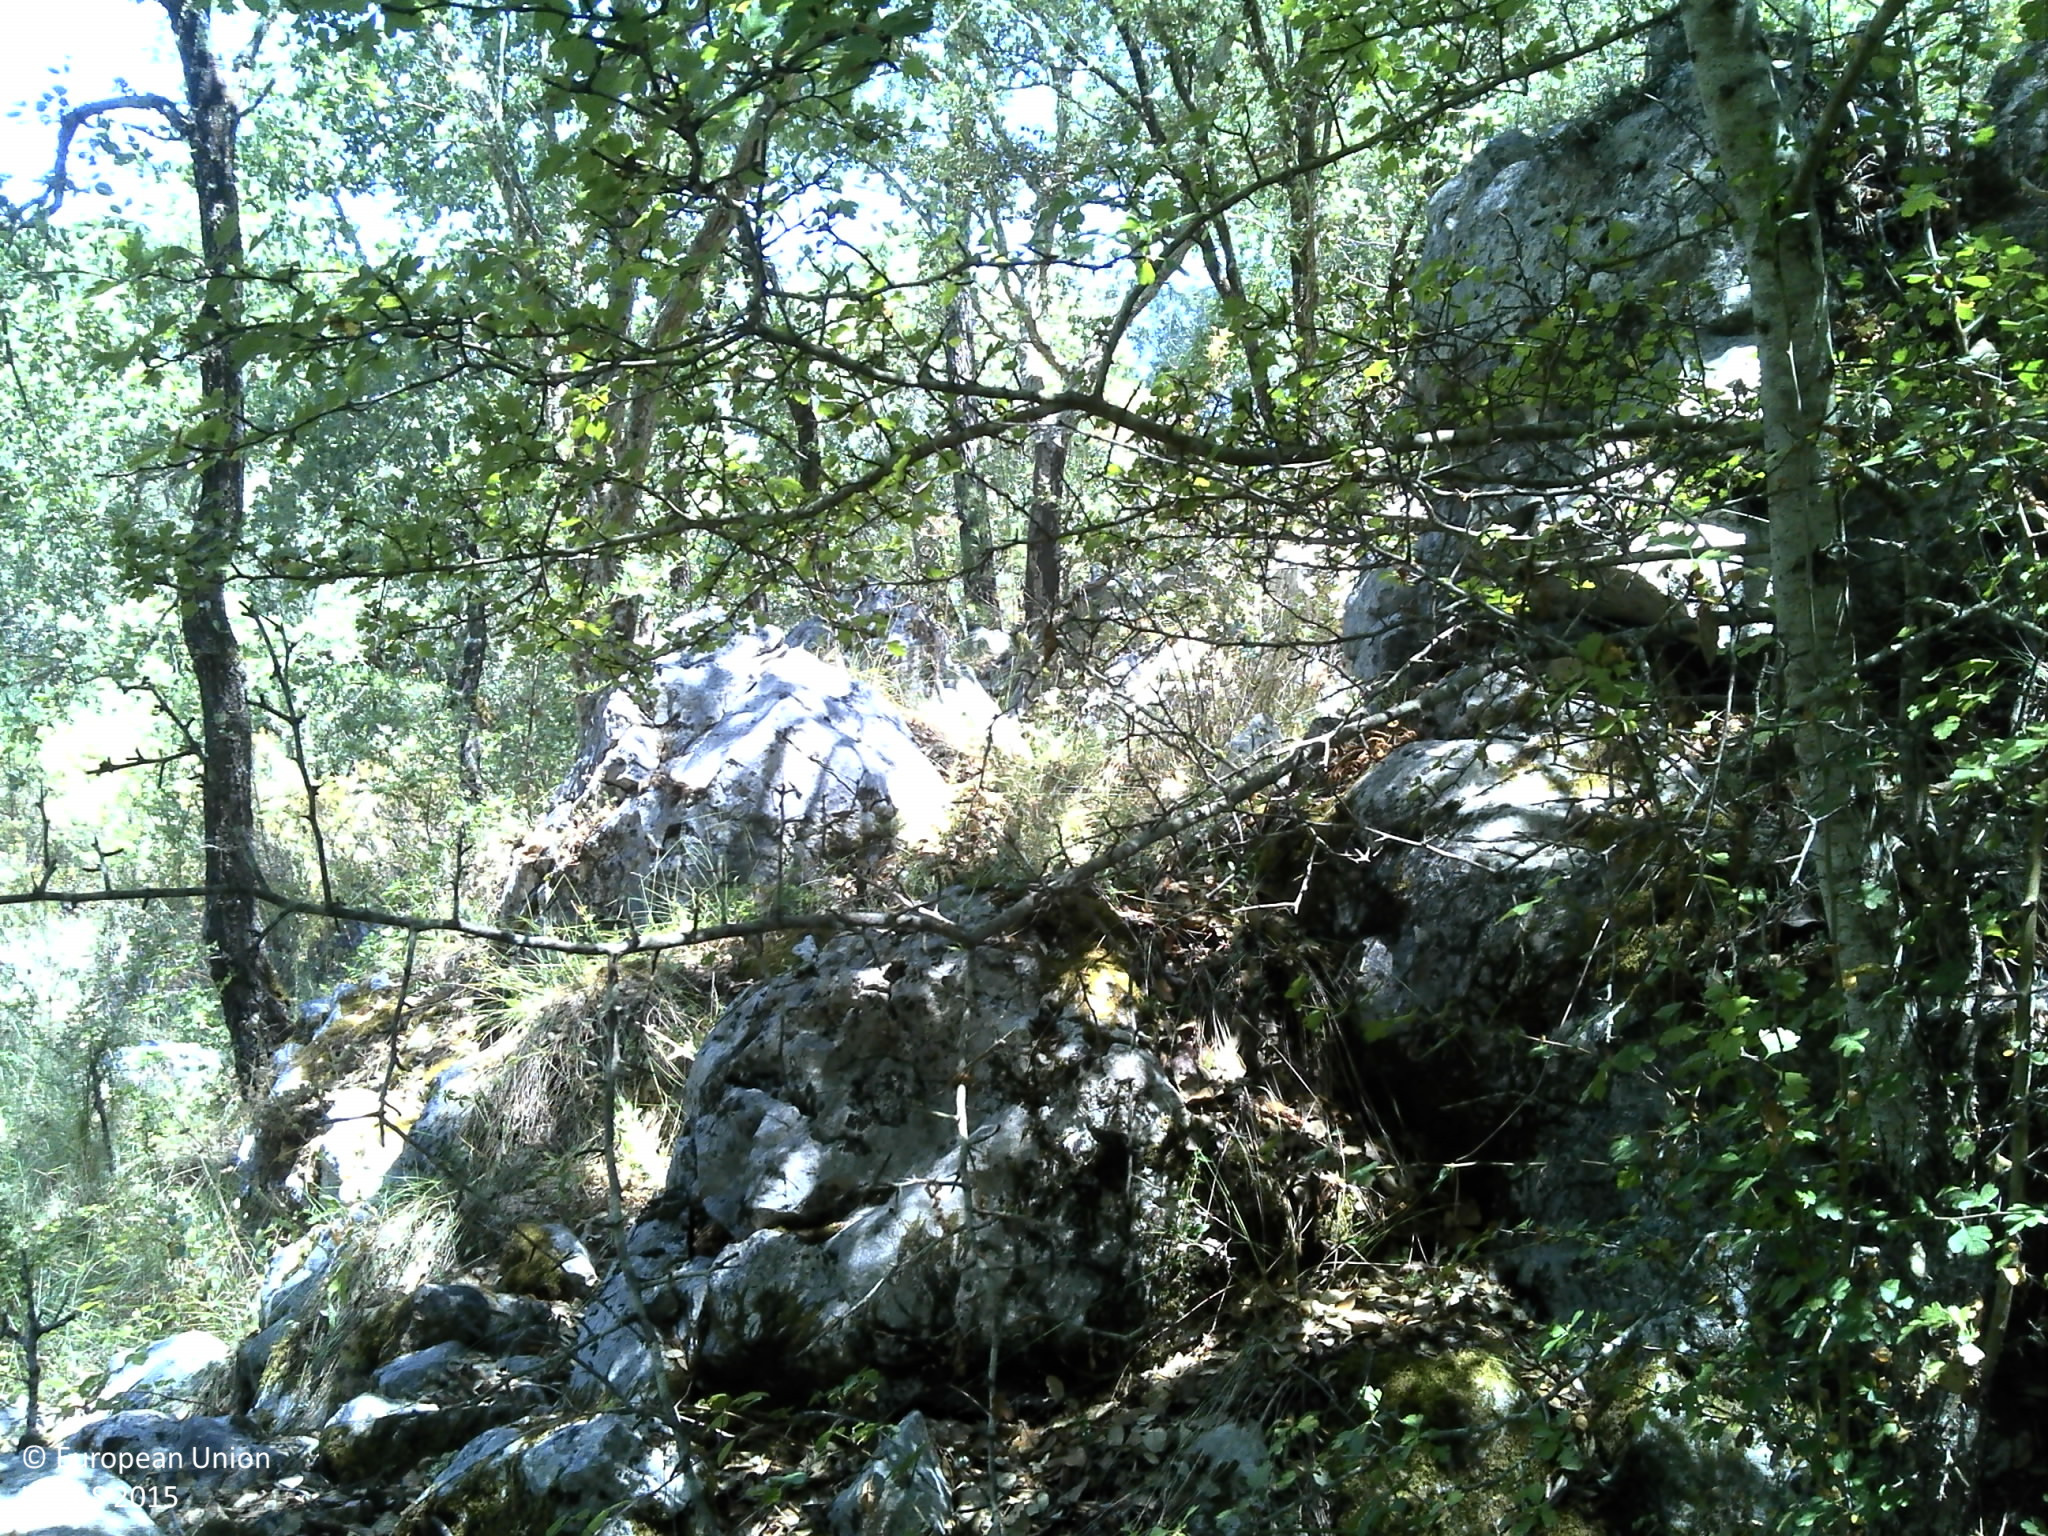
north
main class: Woodland
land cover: Broadleaved woodland
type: acidophilous oak and oak-birch forest
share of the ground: 50 - 75 %
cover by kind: broadleaved forest trees 55 %, herbaceous plants 30 %, unconsolidated bare surface 10 %, shrubs 5 %
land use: Forestry
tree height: > 5 m
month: July
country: PT
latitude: 39.8353
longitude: -8.4345
